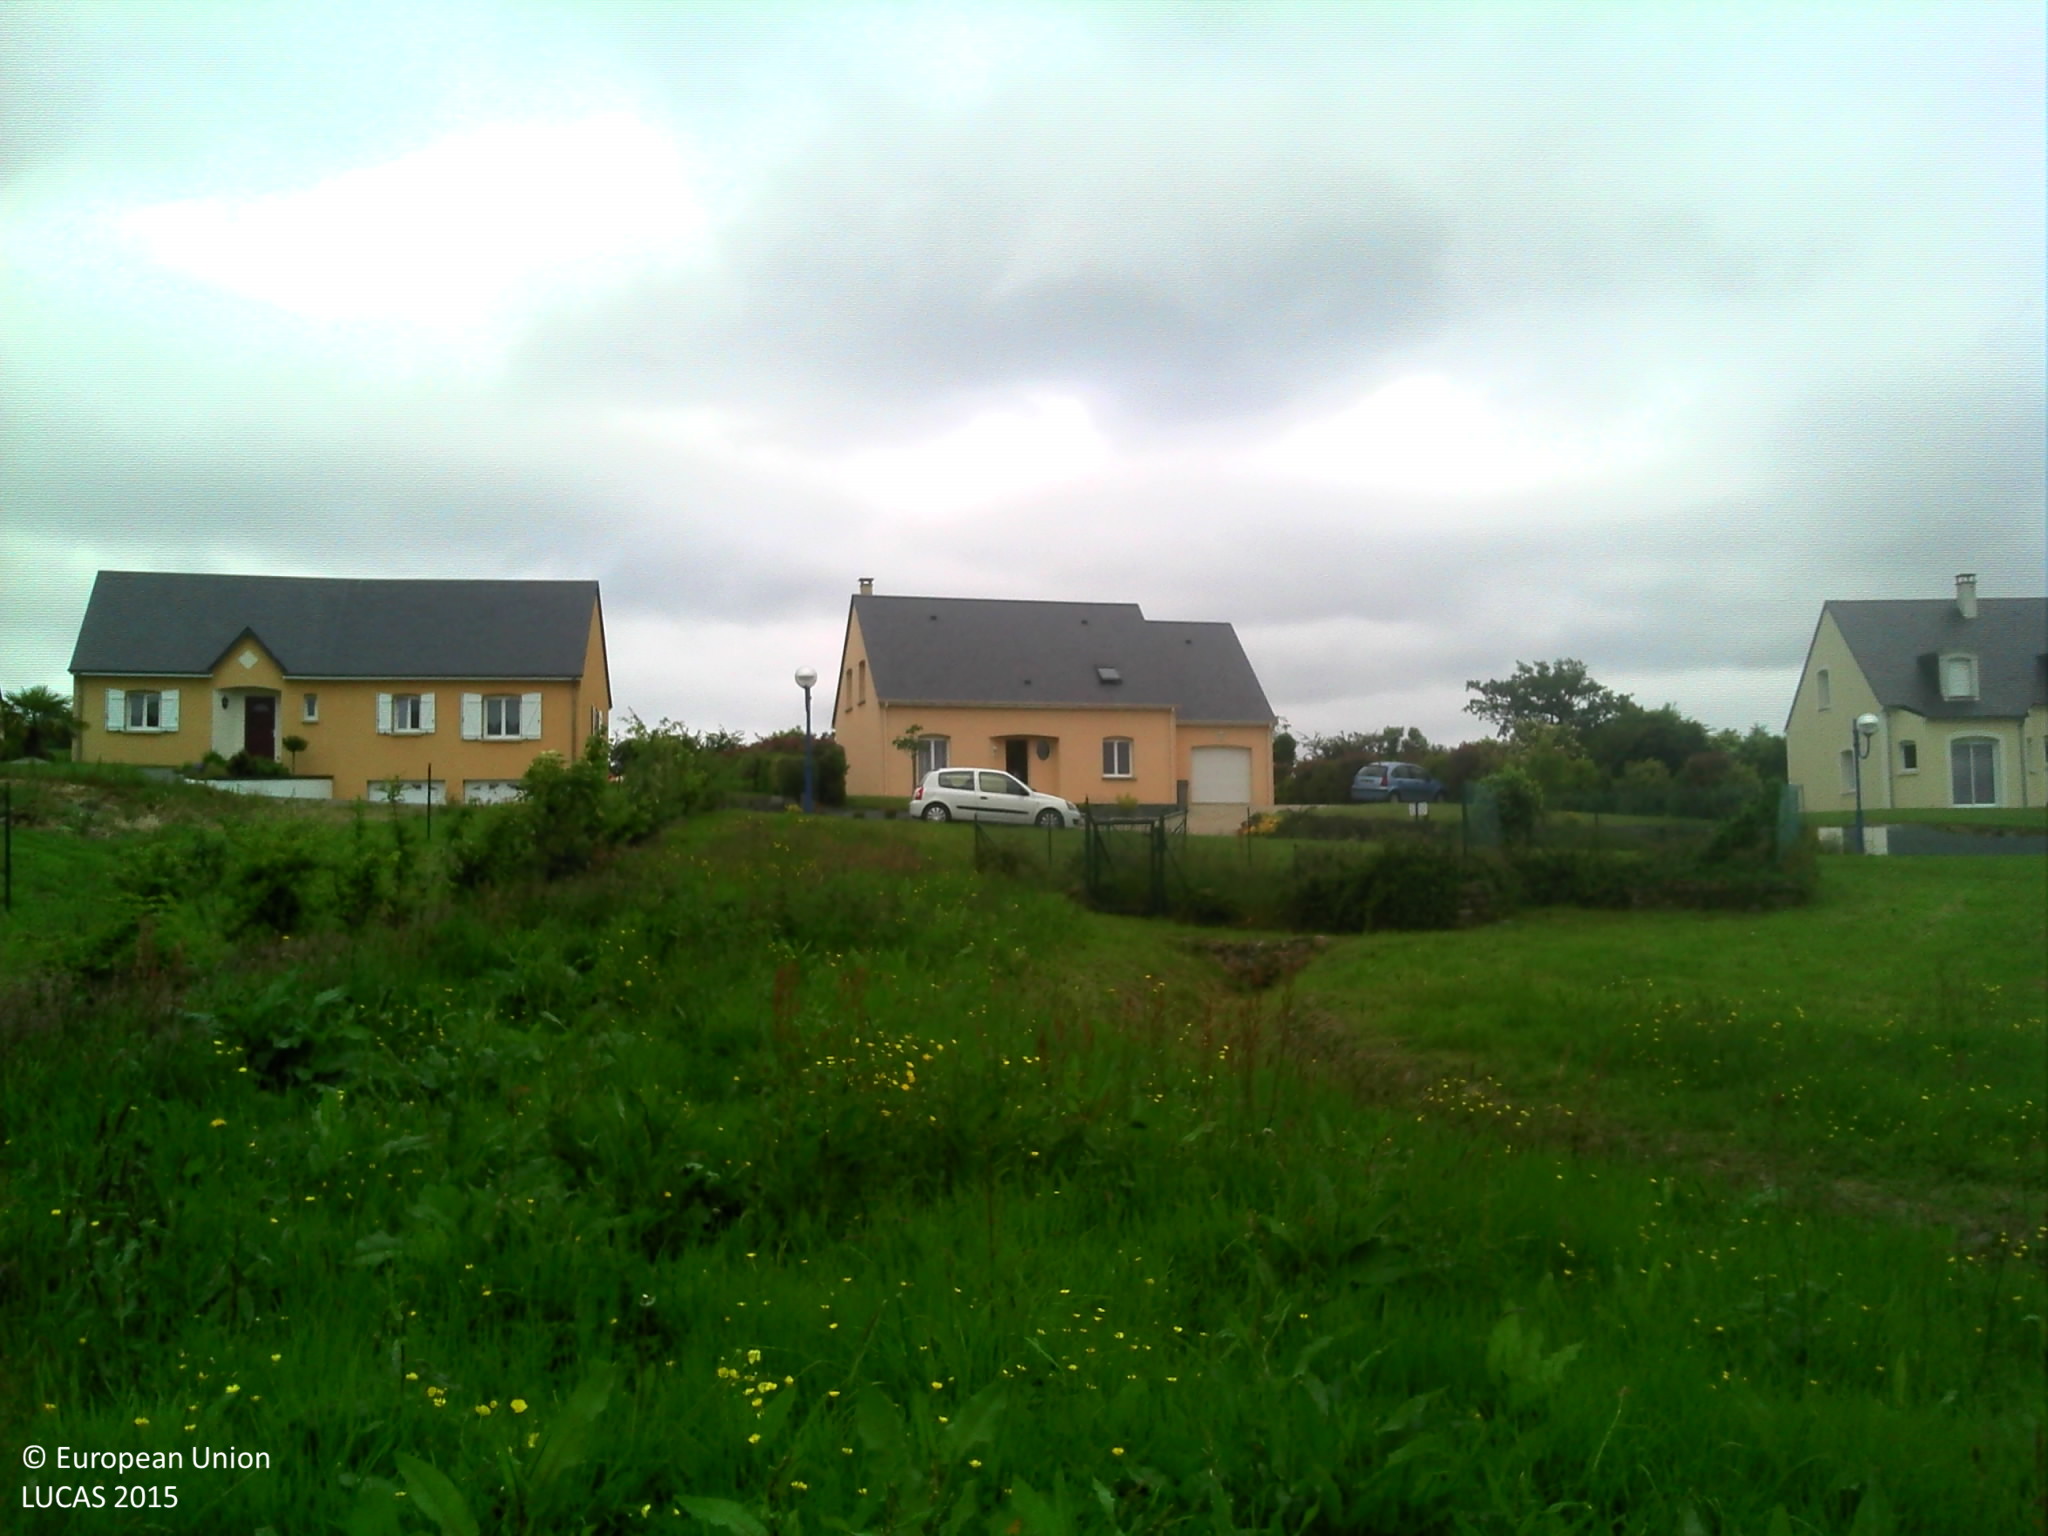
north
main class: Grassland
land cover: Grassland without tree/shrub cover
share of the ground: > 75 %
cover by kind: herbaceous plants 100 %
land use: Residential
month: May
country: FR
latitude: 48.1907
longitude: -0.1325
